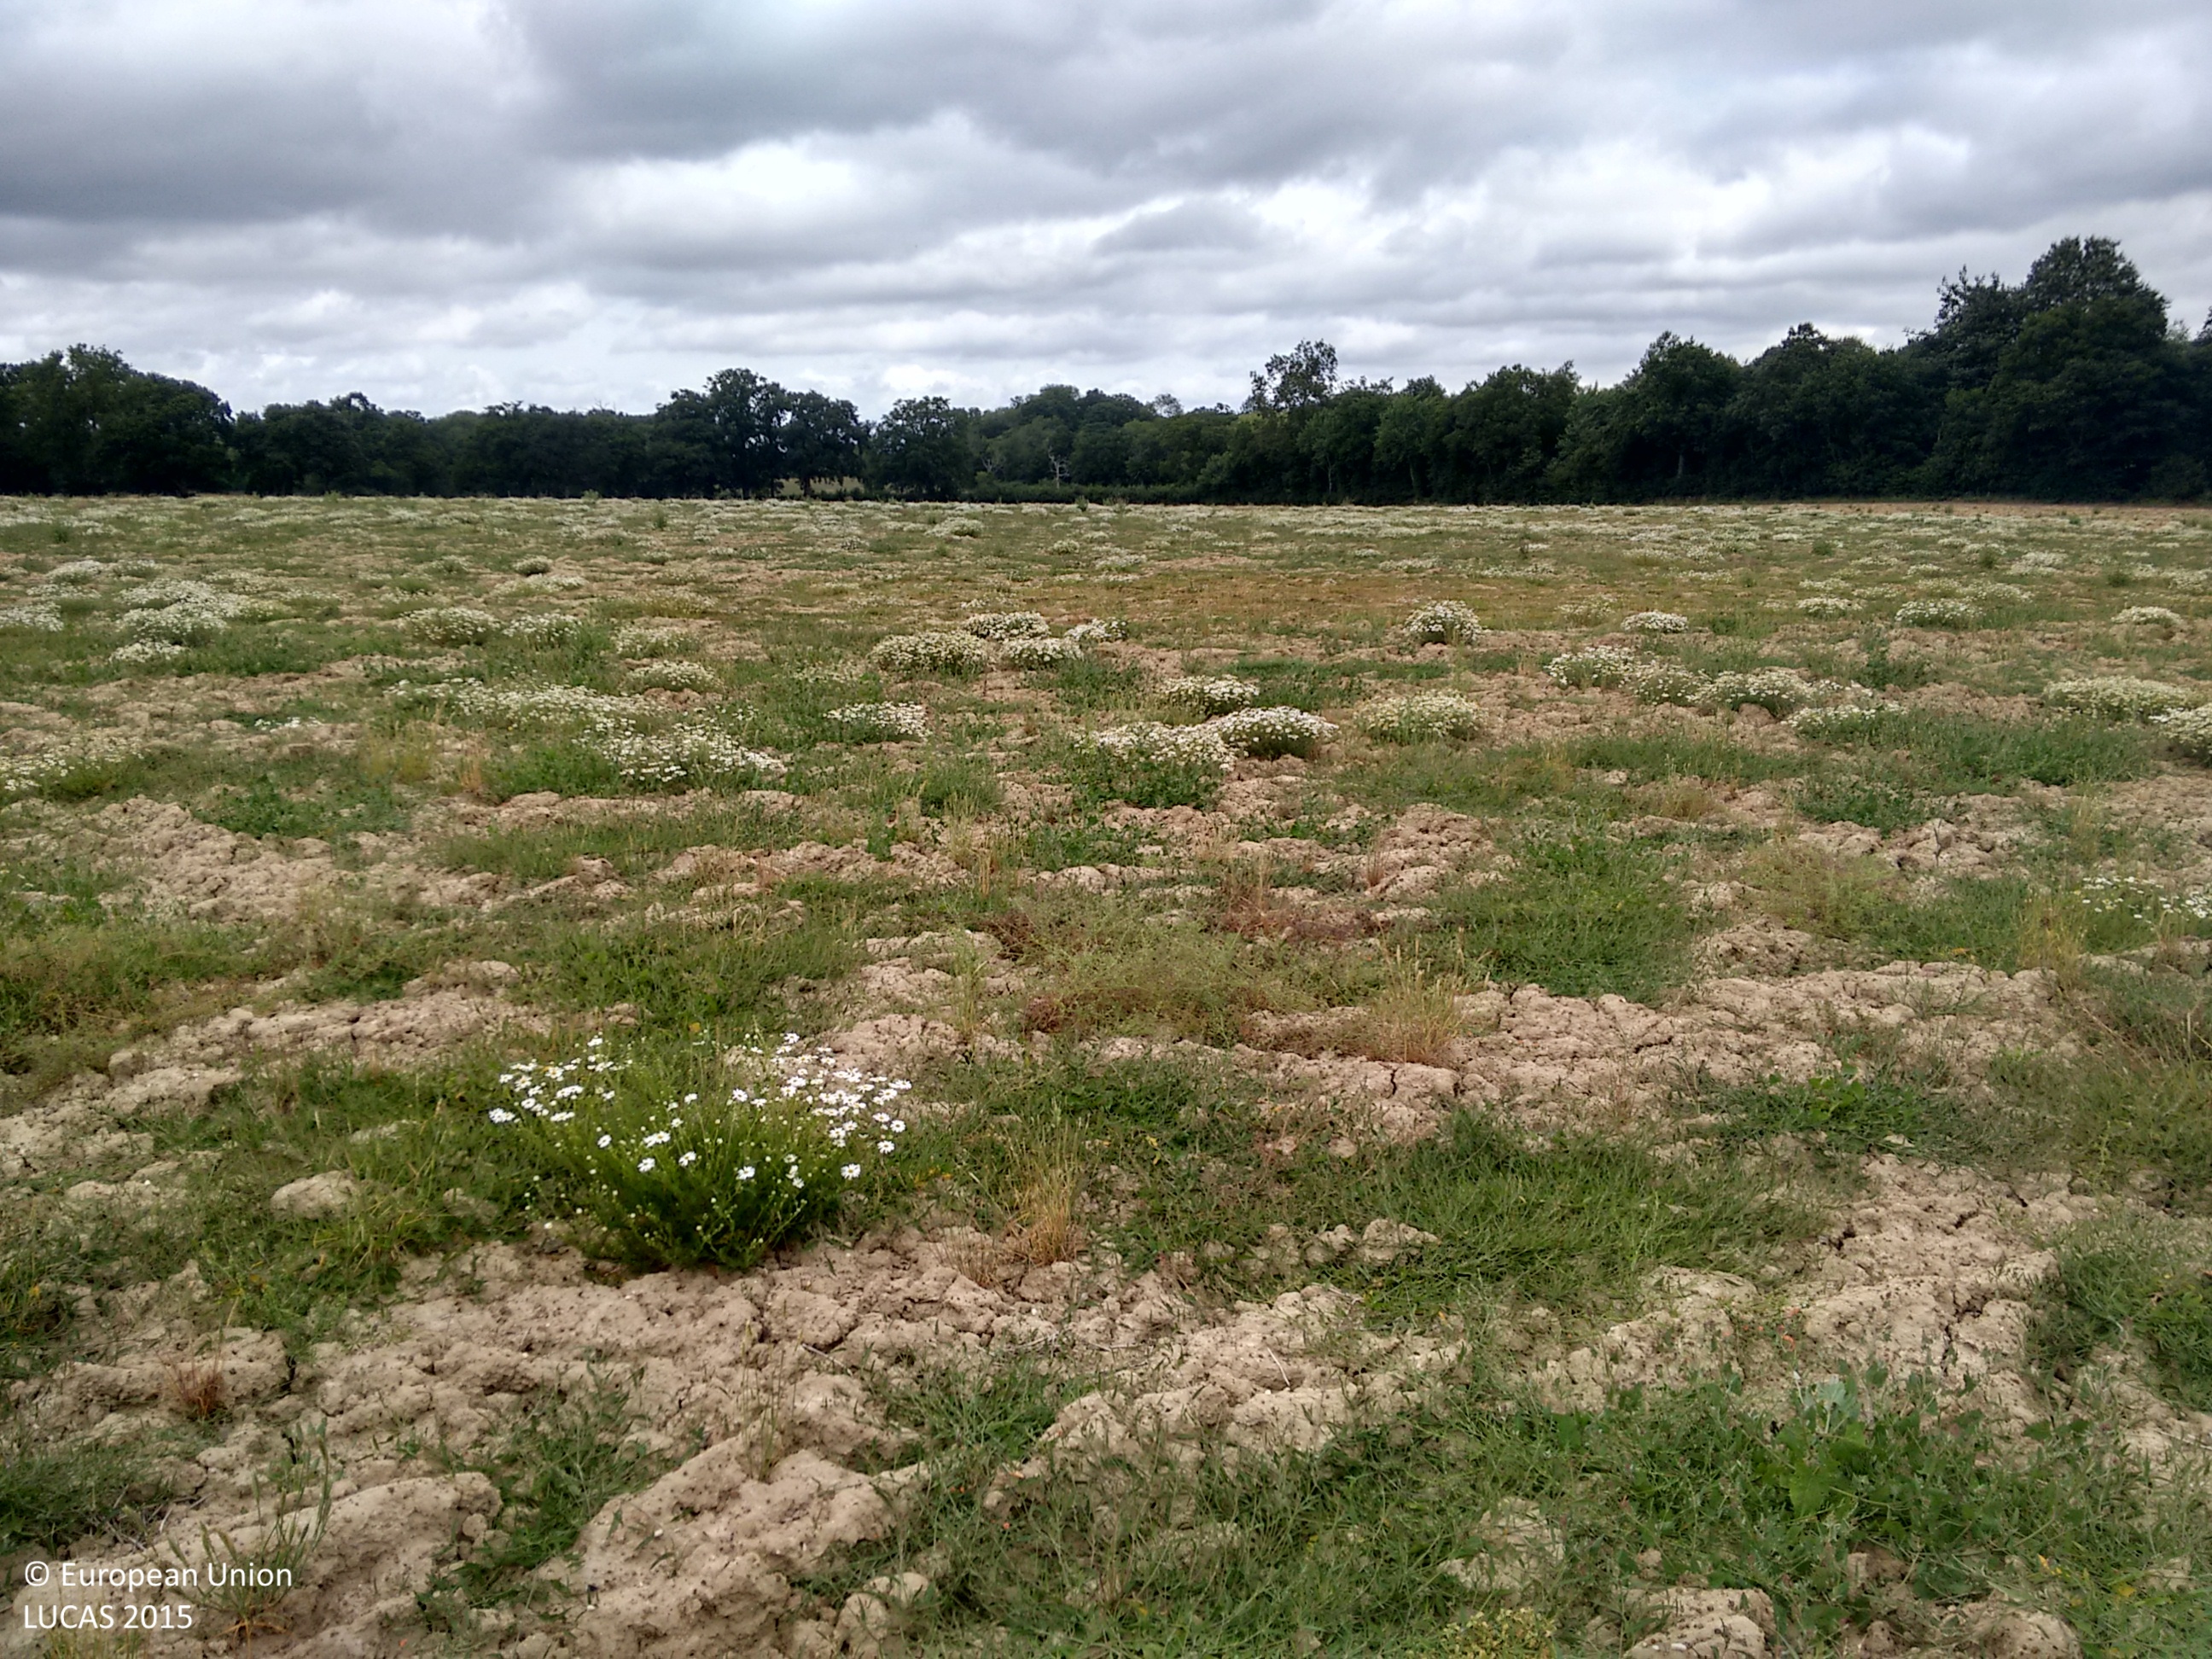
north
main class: Grassland
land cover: Spontaneously vegetated surfaces
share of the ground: 25 - 50 %
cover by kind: herbaceous plants 60 %, unconsolidated bare surface 40 %
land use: Fallow land
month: July
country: GB
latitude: 51.0940
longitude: -0.5046
